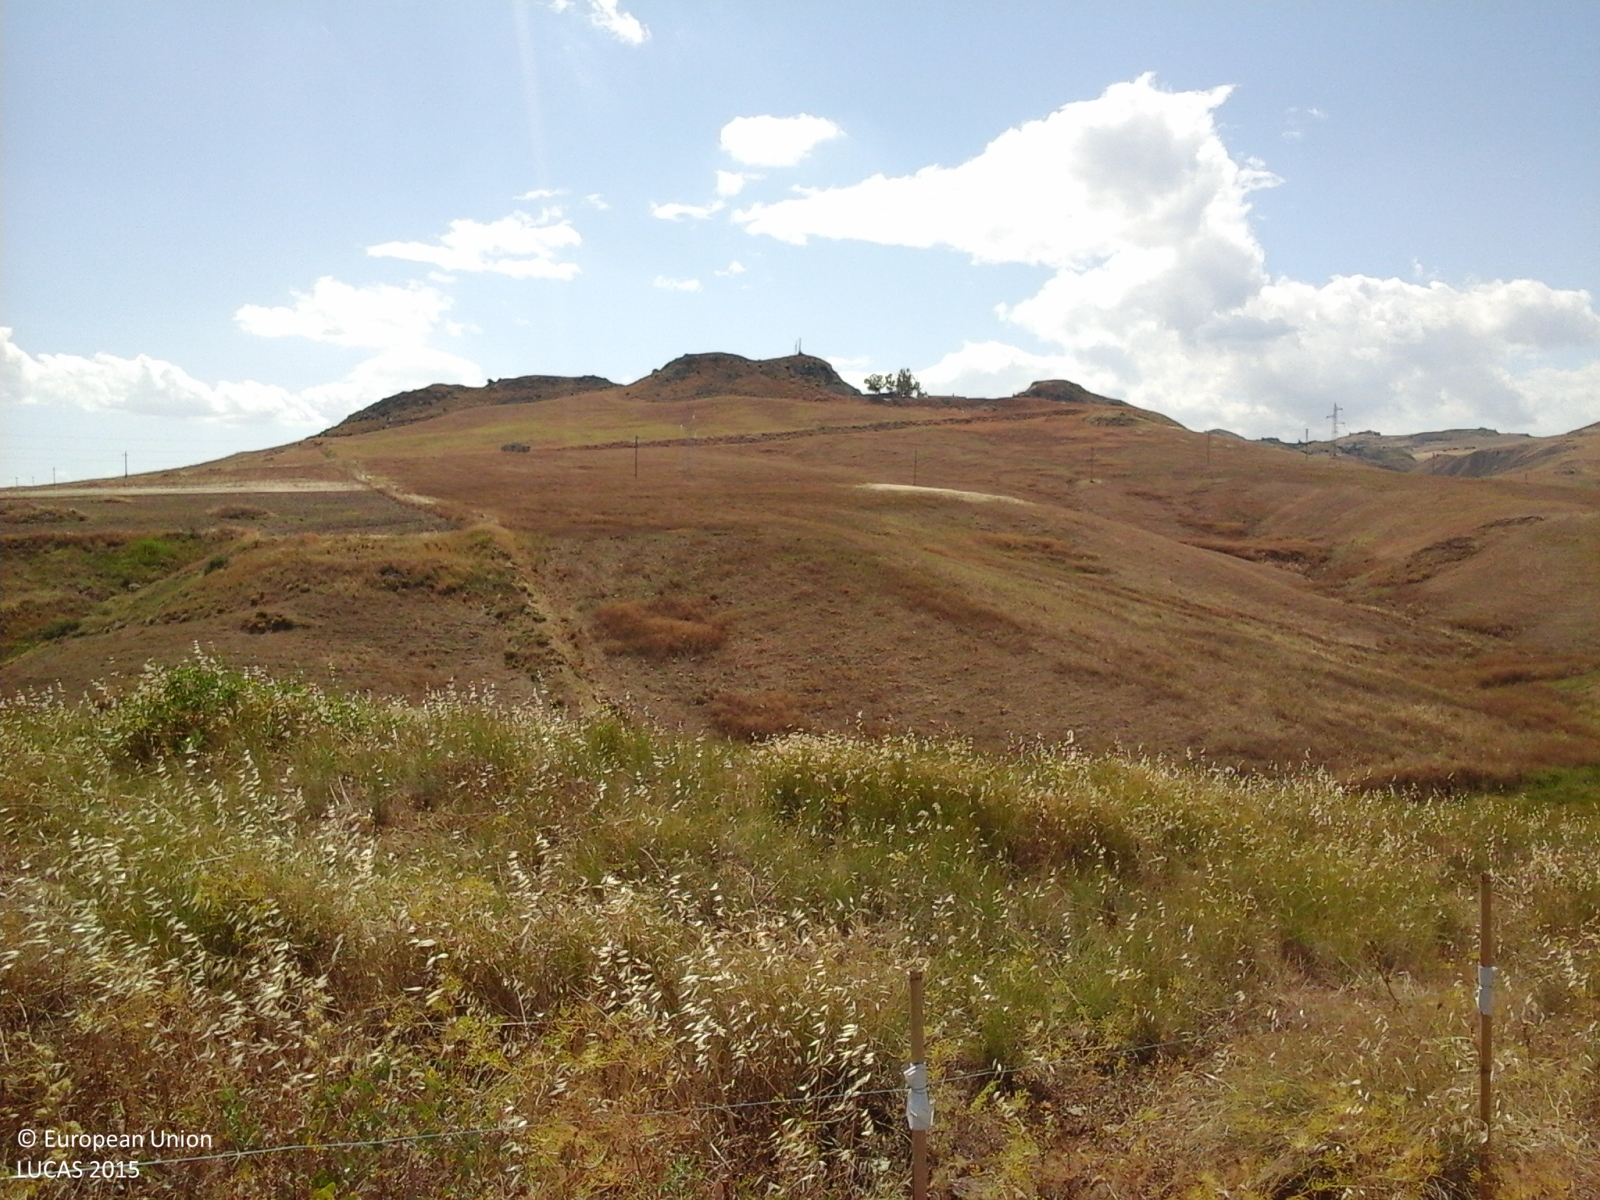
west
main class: Grassland
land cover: Grassland without tree/shrub cover
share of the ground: > 75 %
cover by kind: herbaceous plants 95 %, shrubs 5 %
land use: Agriculture (excluding fallow land and kitchen gardens)
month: June
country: IT
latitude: 37.5513
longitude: 14.8438
